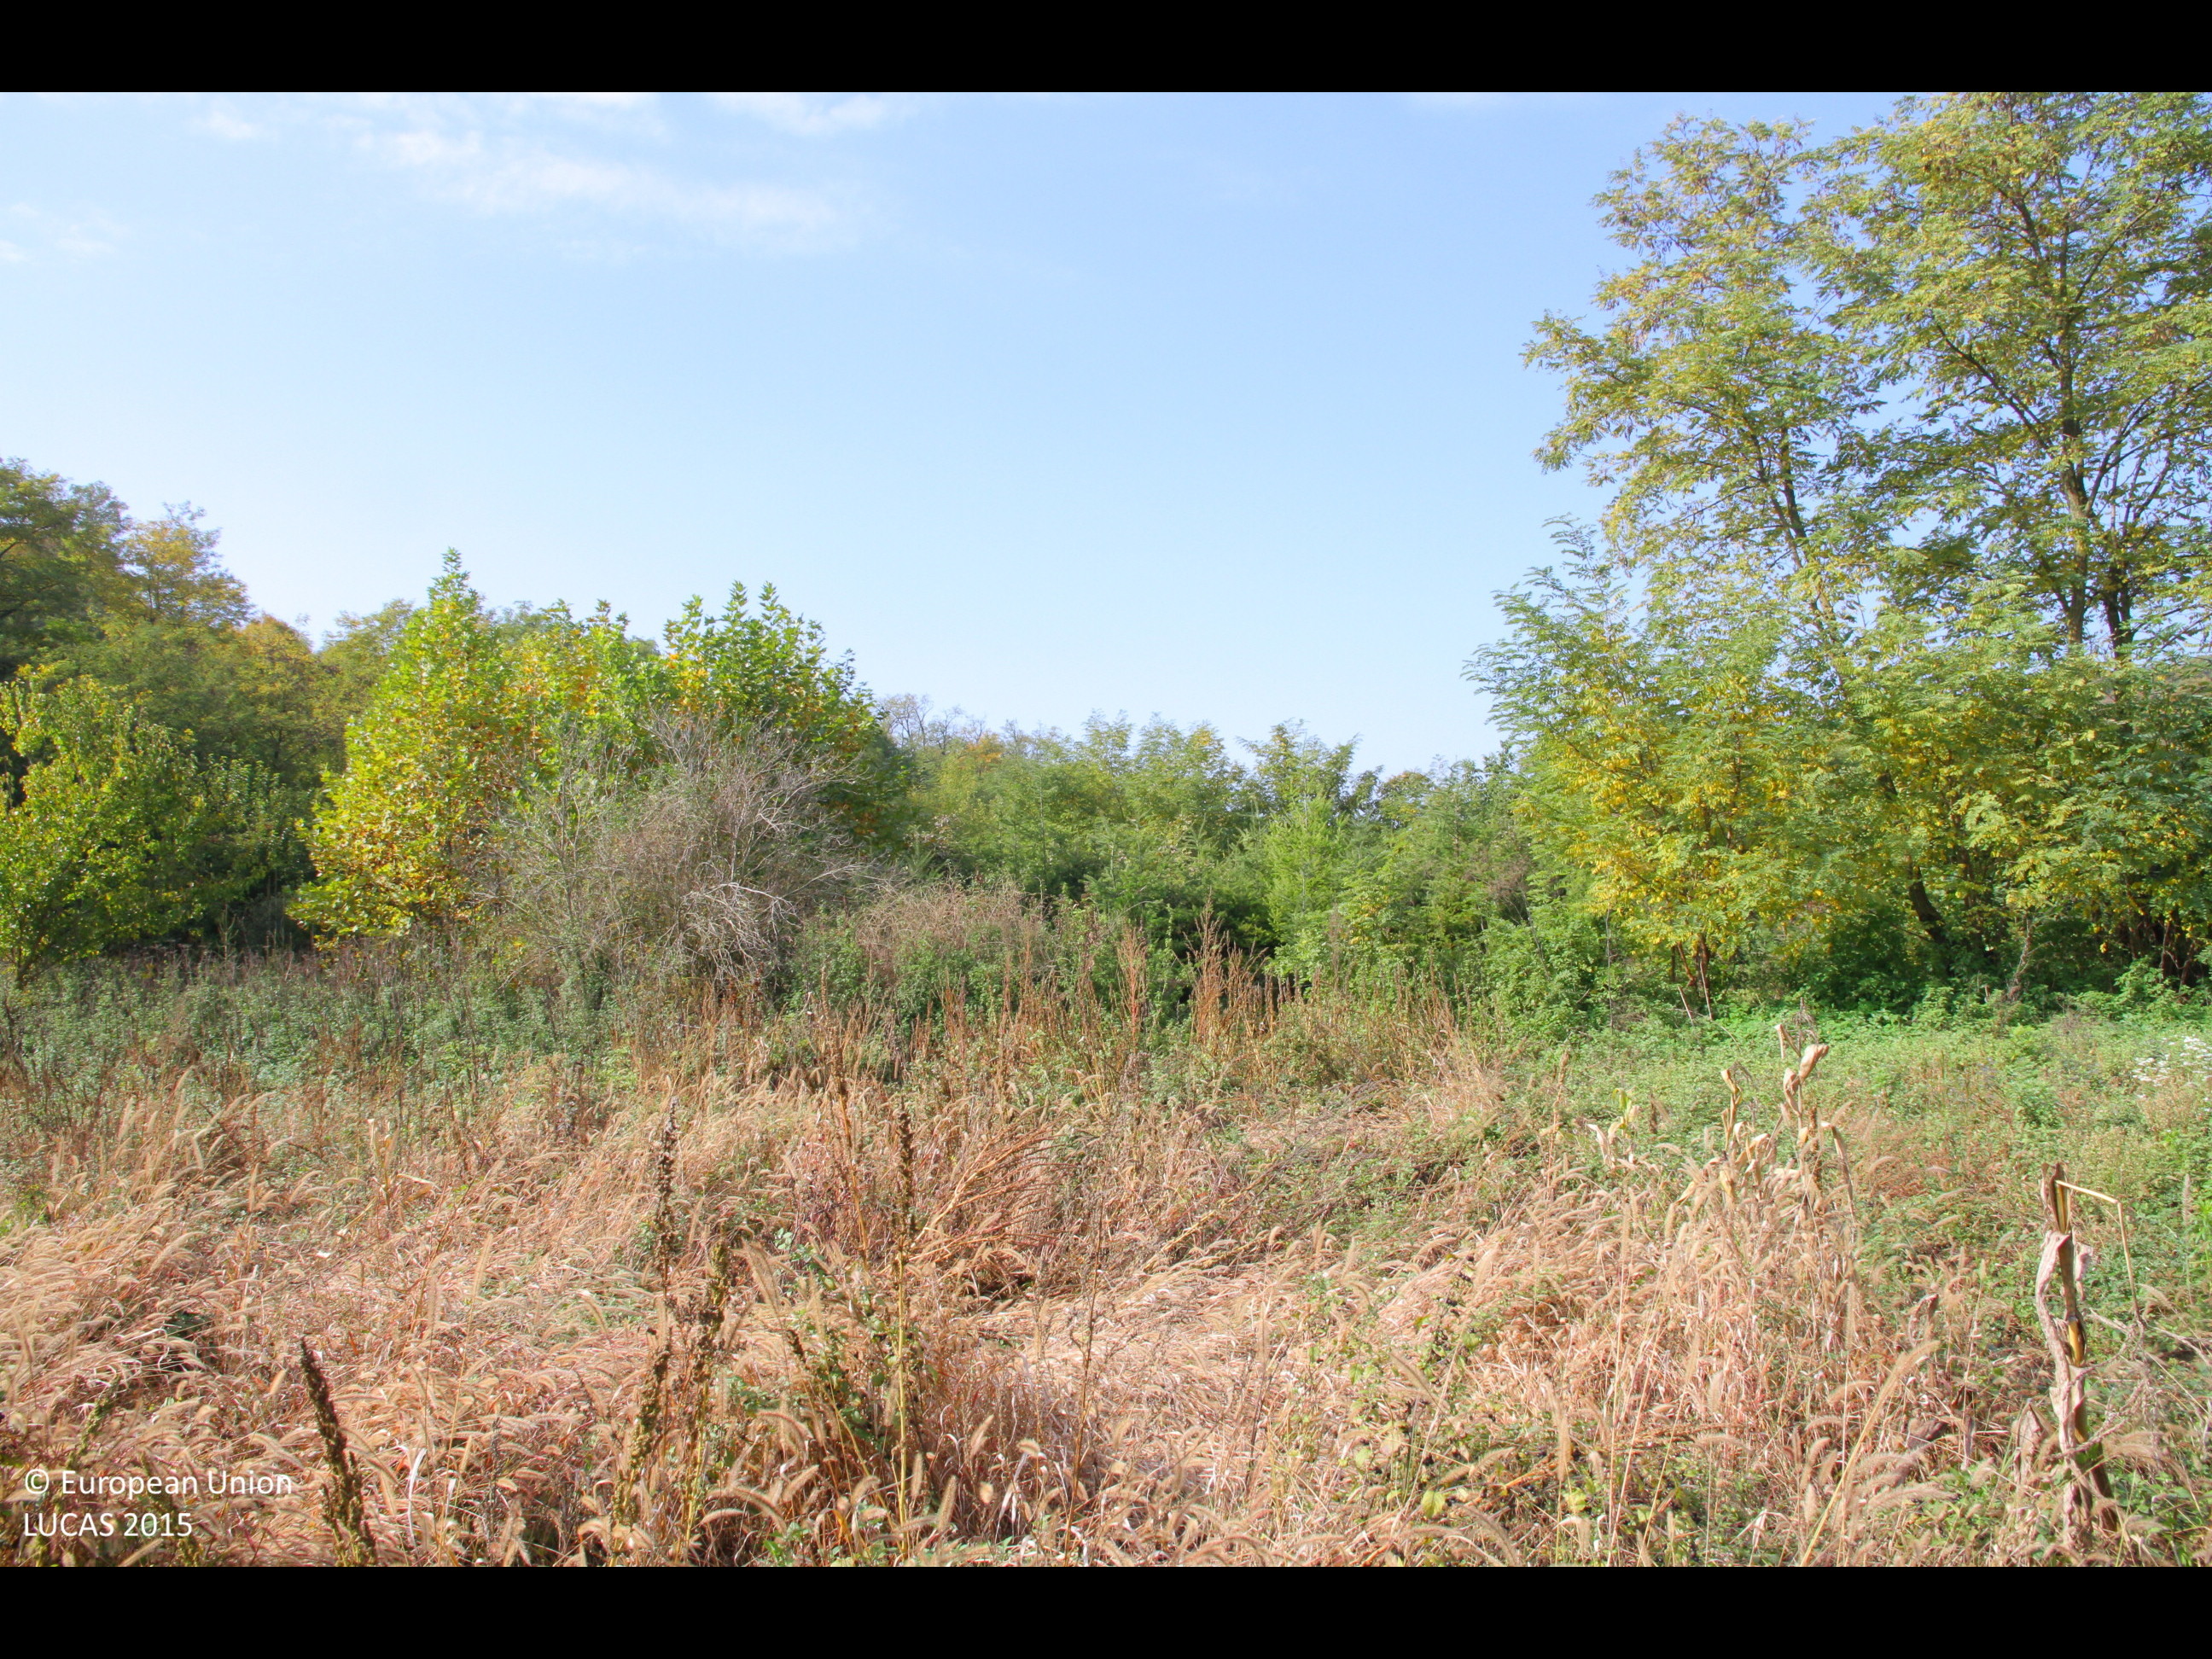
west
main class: Grassland
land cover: Spontaneously vegetated surfaces
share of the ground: > 75 %
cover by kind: herbaceous plants 95 %, shrubs 5 %
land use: Agriculture (excluding fallow land and kitchen gardens)
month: October
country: BG
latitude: 43.6445
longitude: 26.3807
